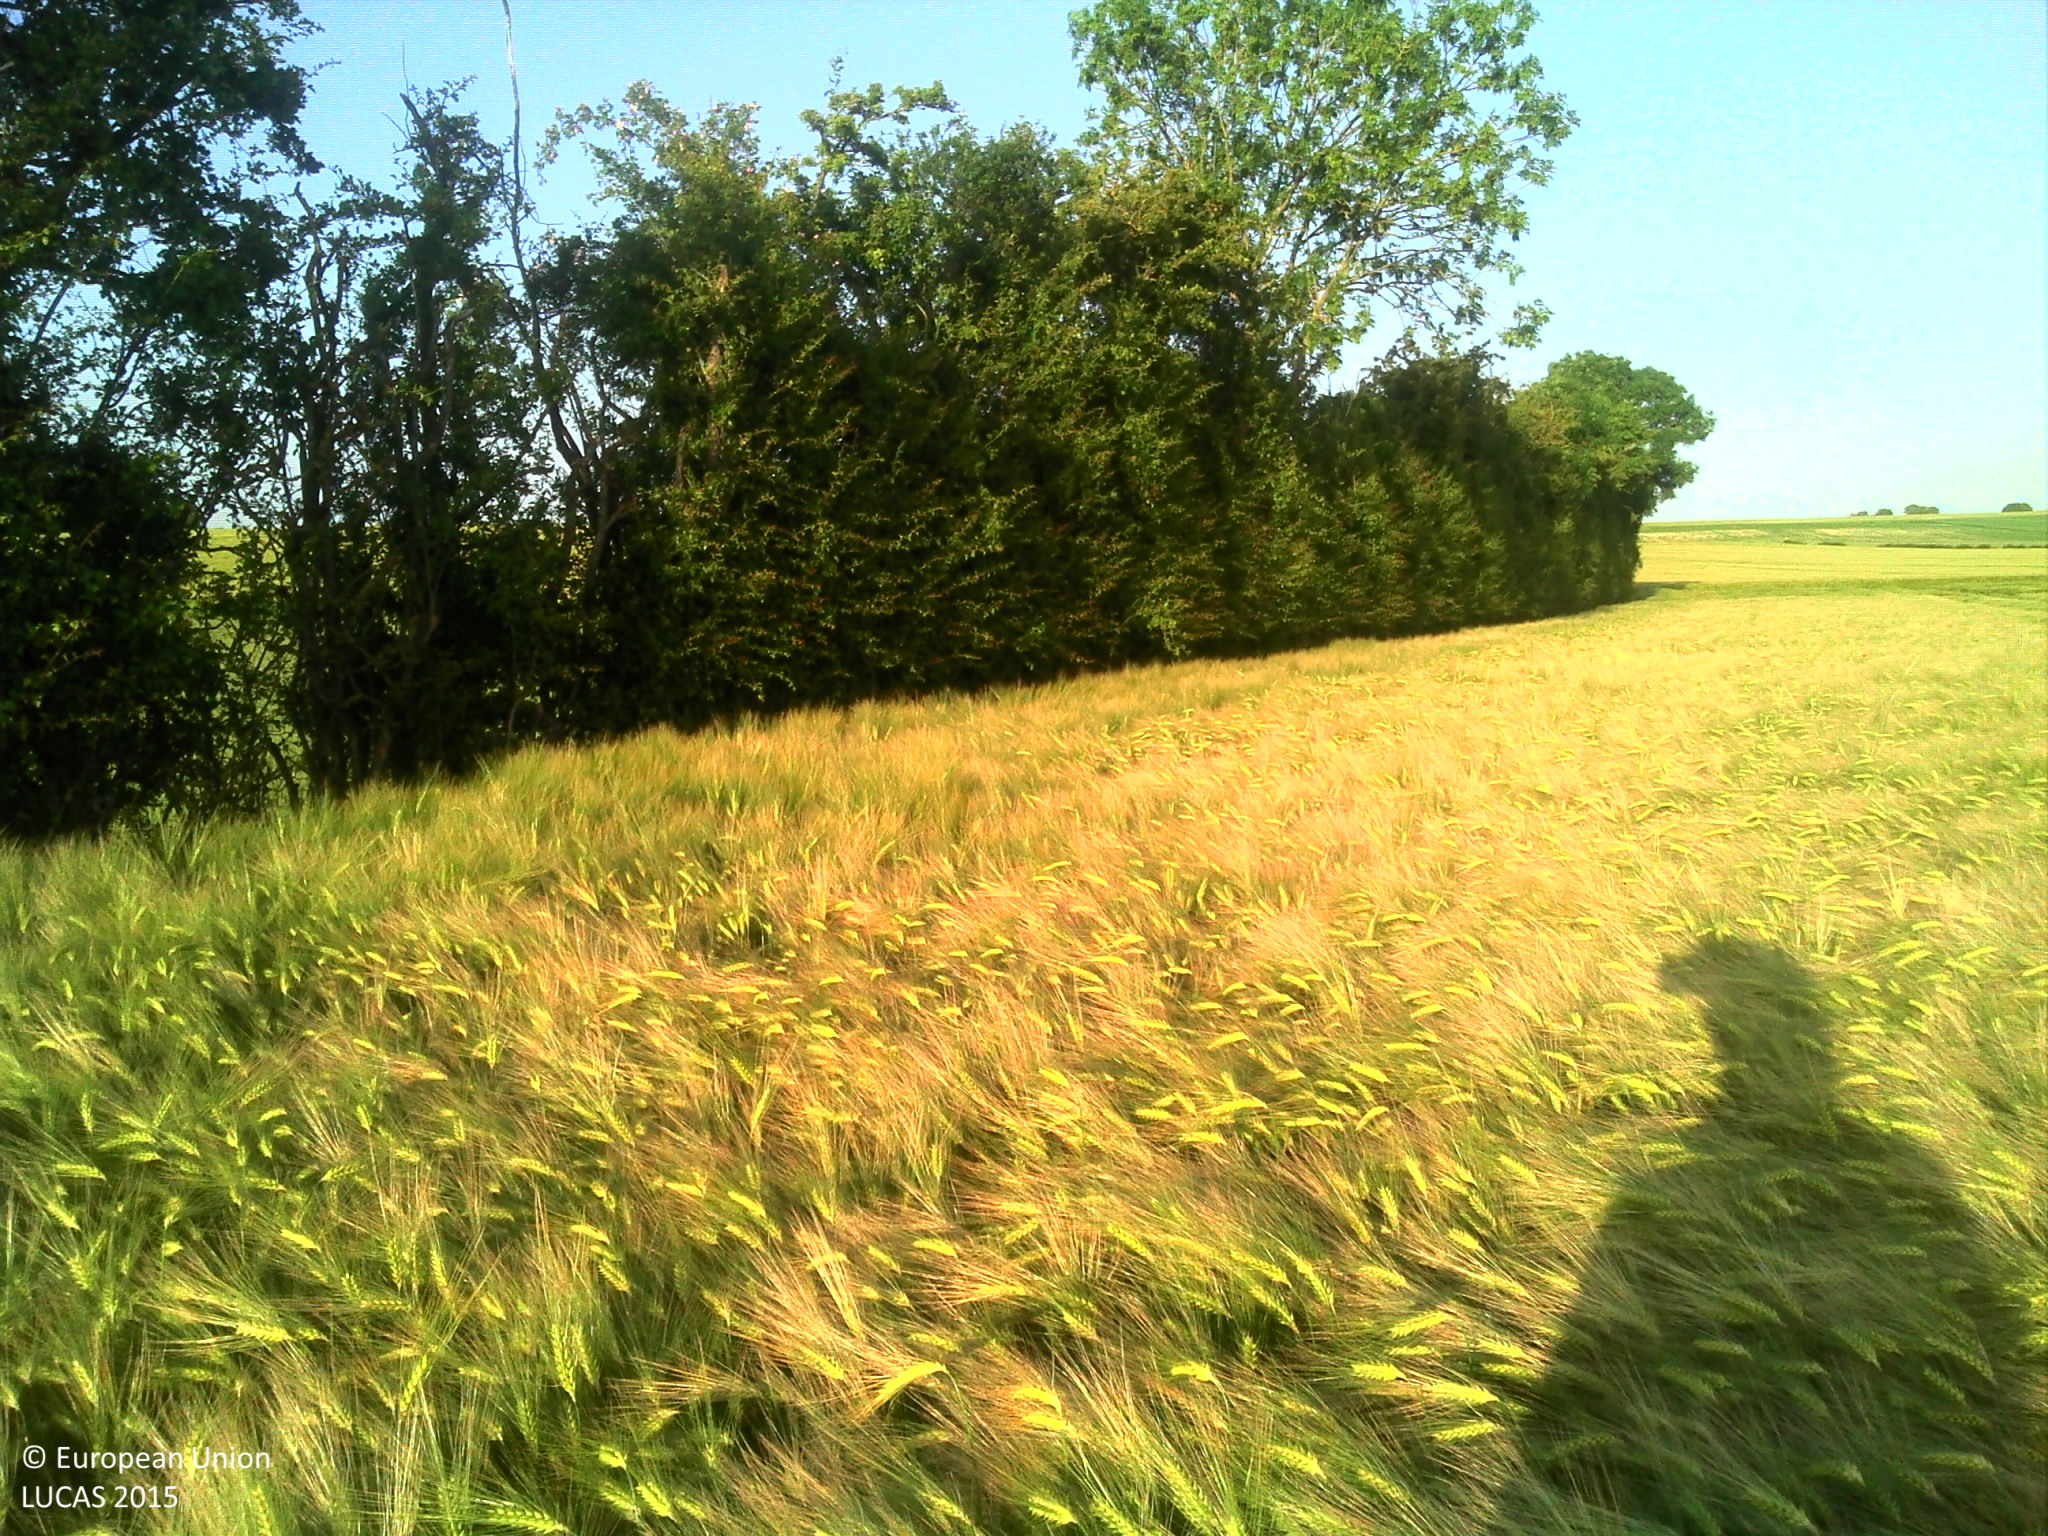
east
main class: Cropland
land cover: Barley
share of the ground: > 75 %
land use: Agriculture (excluding fallow land and kitchen gardens)
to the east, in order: Barley; Grass margins; Managed hedges; Fences; Grass margins; Barley; Grass margins; Paved roads, cycling and walking lanes; Grass margins; Barley
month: June
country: FR
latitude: 48.7897
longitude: 0.0749
